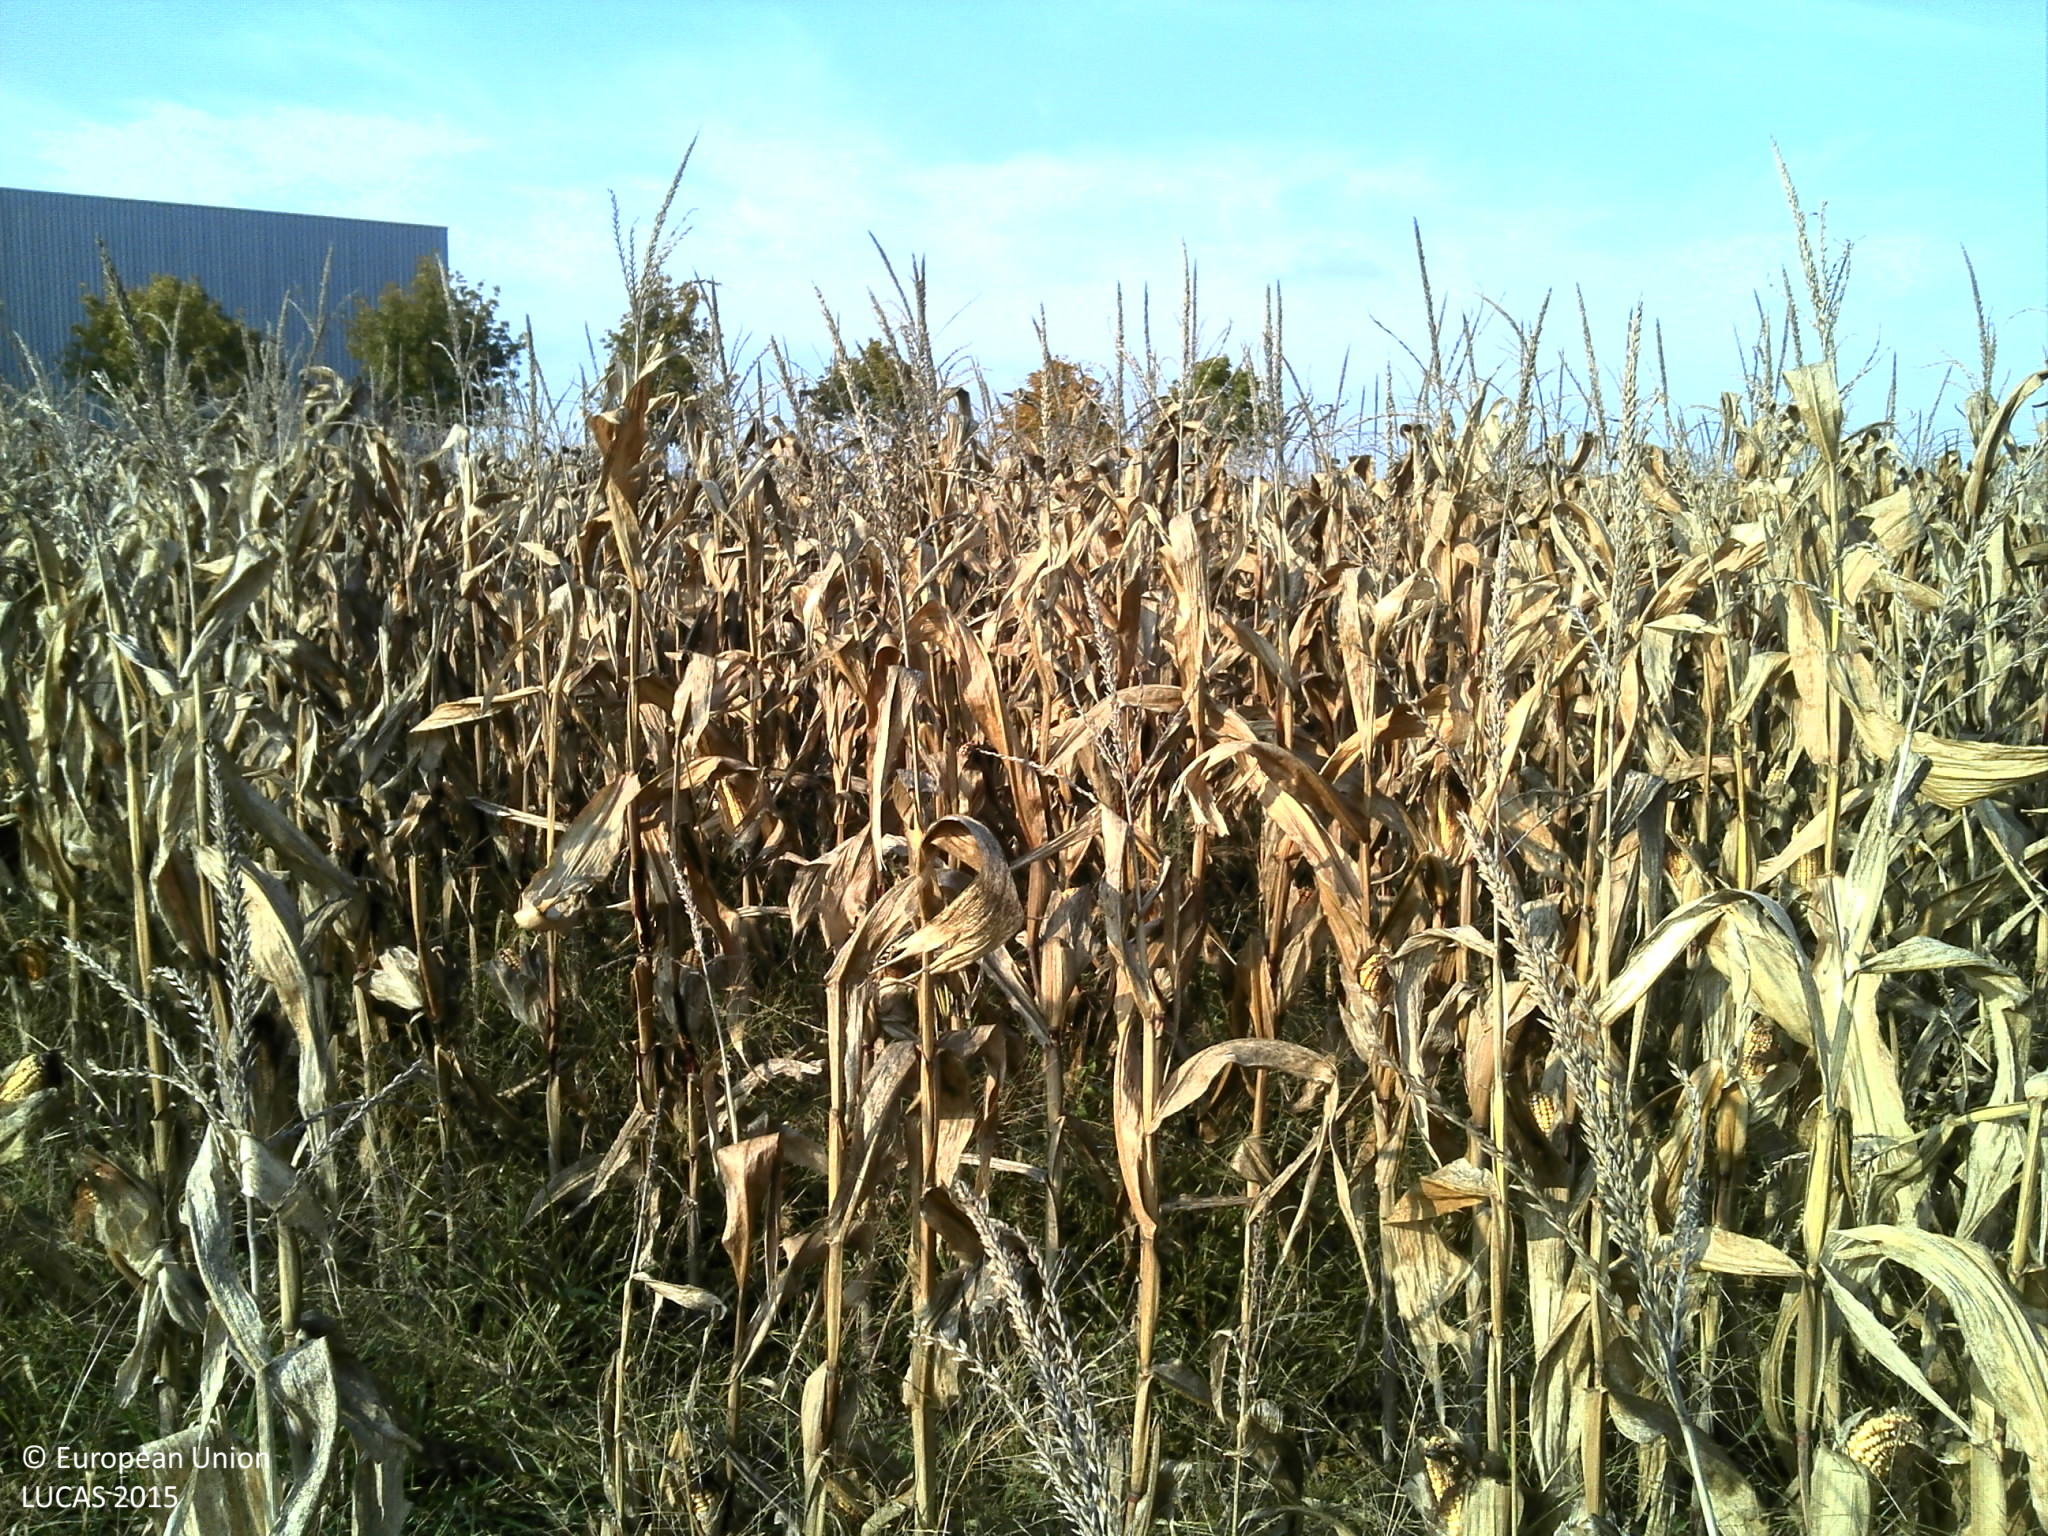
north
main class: Cropland
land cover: Maize
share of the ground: > 75 %
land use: Agriculture (excluding fallow land and kitchen gardens)
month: October
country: FR
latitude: 46.2859
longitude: 5.3433
